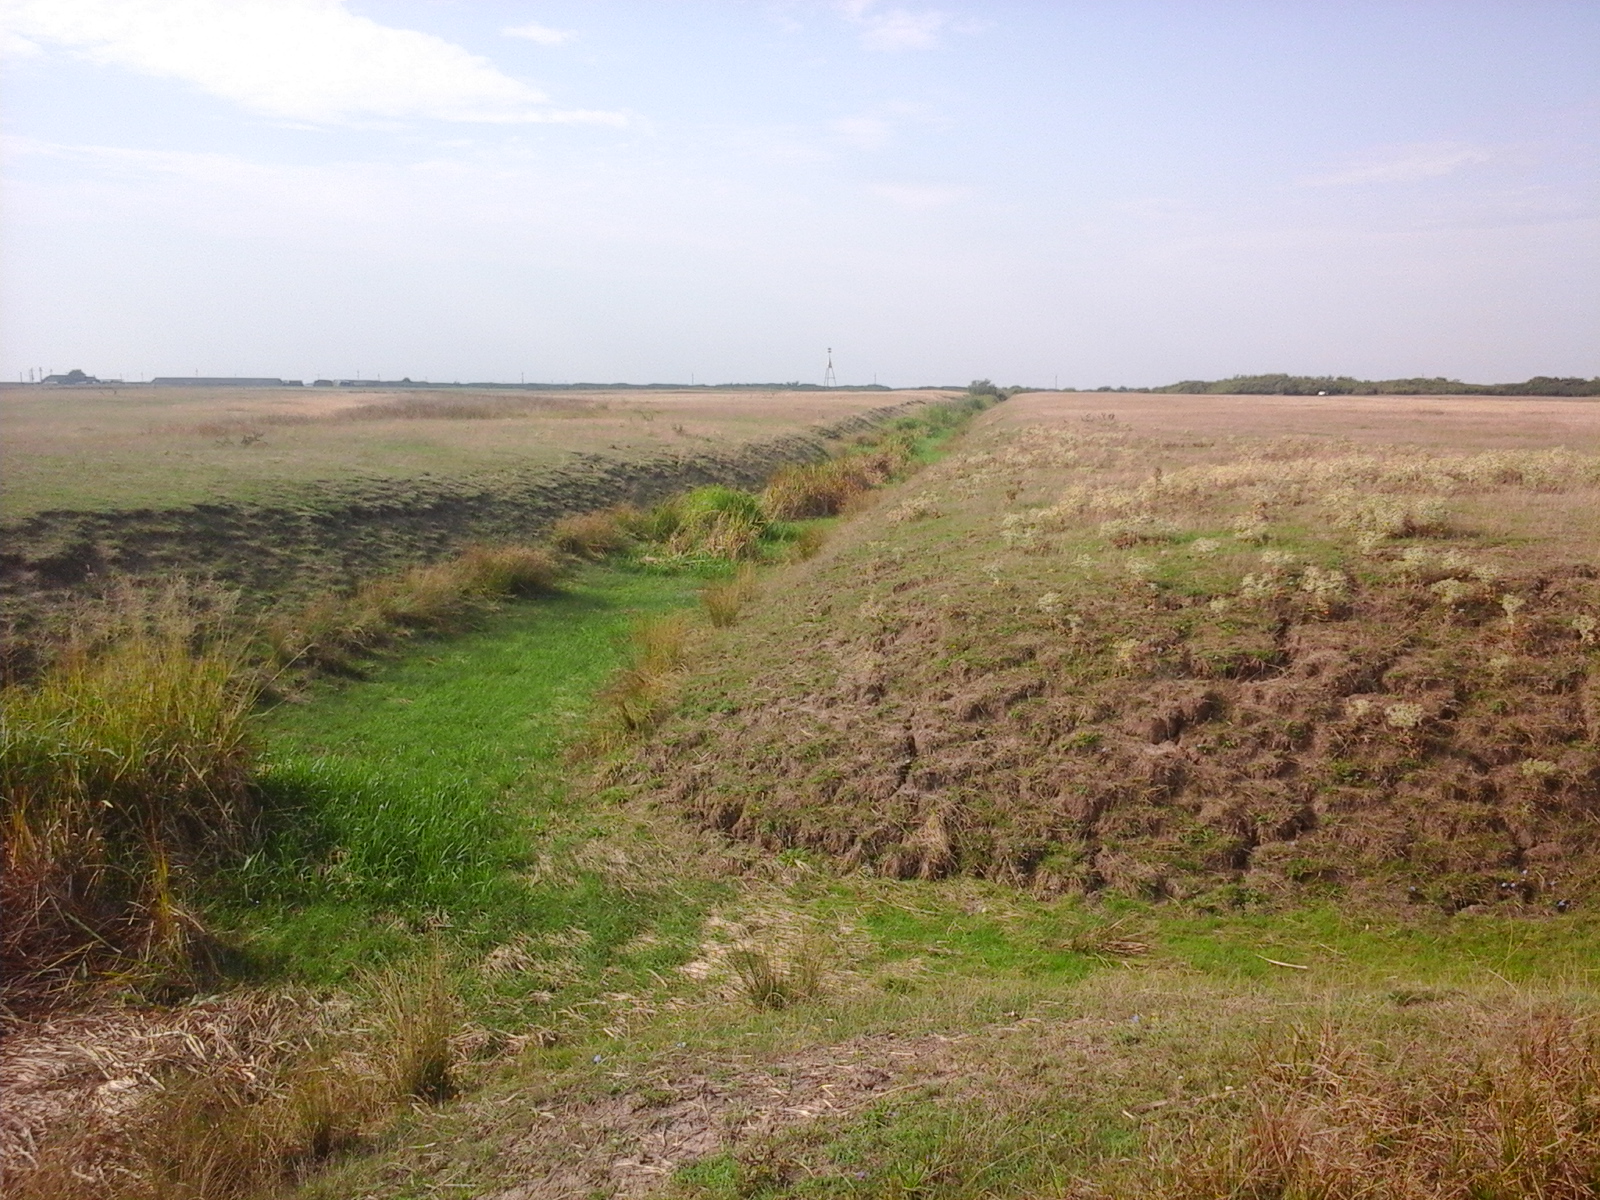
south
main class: Grassland
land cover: Grassland without tree/shrub cover
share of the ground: > 75 %
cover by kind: herbaceous plants 100 %
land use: Agriculture (excluding fallow land and kitchen gardens)
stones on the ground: < 10 %
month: August
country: RO
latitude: 46.7422
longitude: 21.5443
